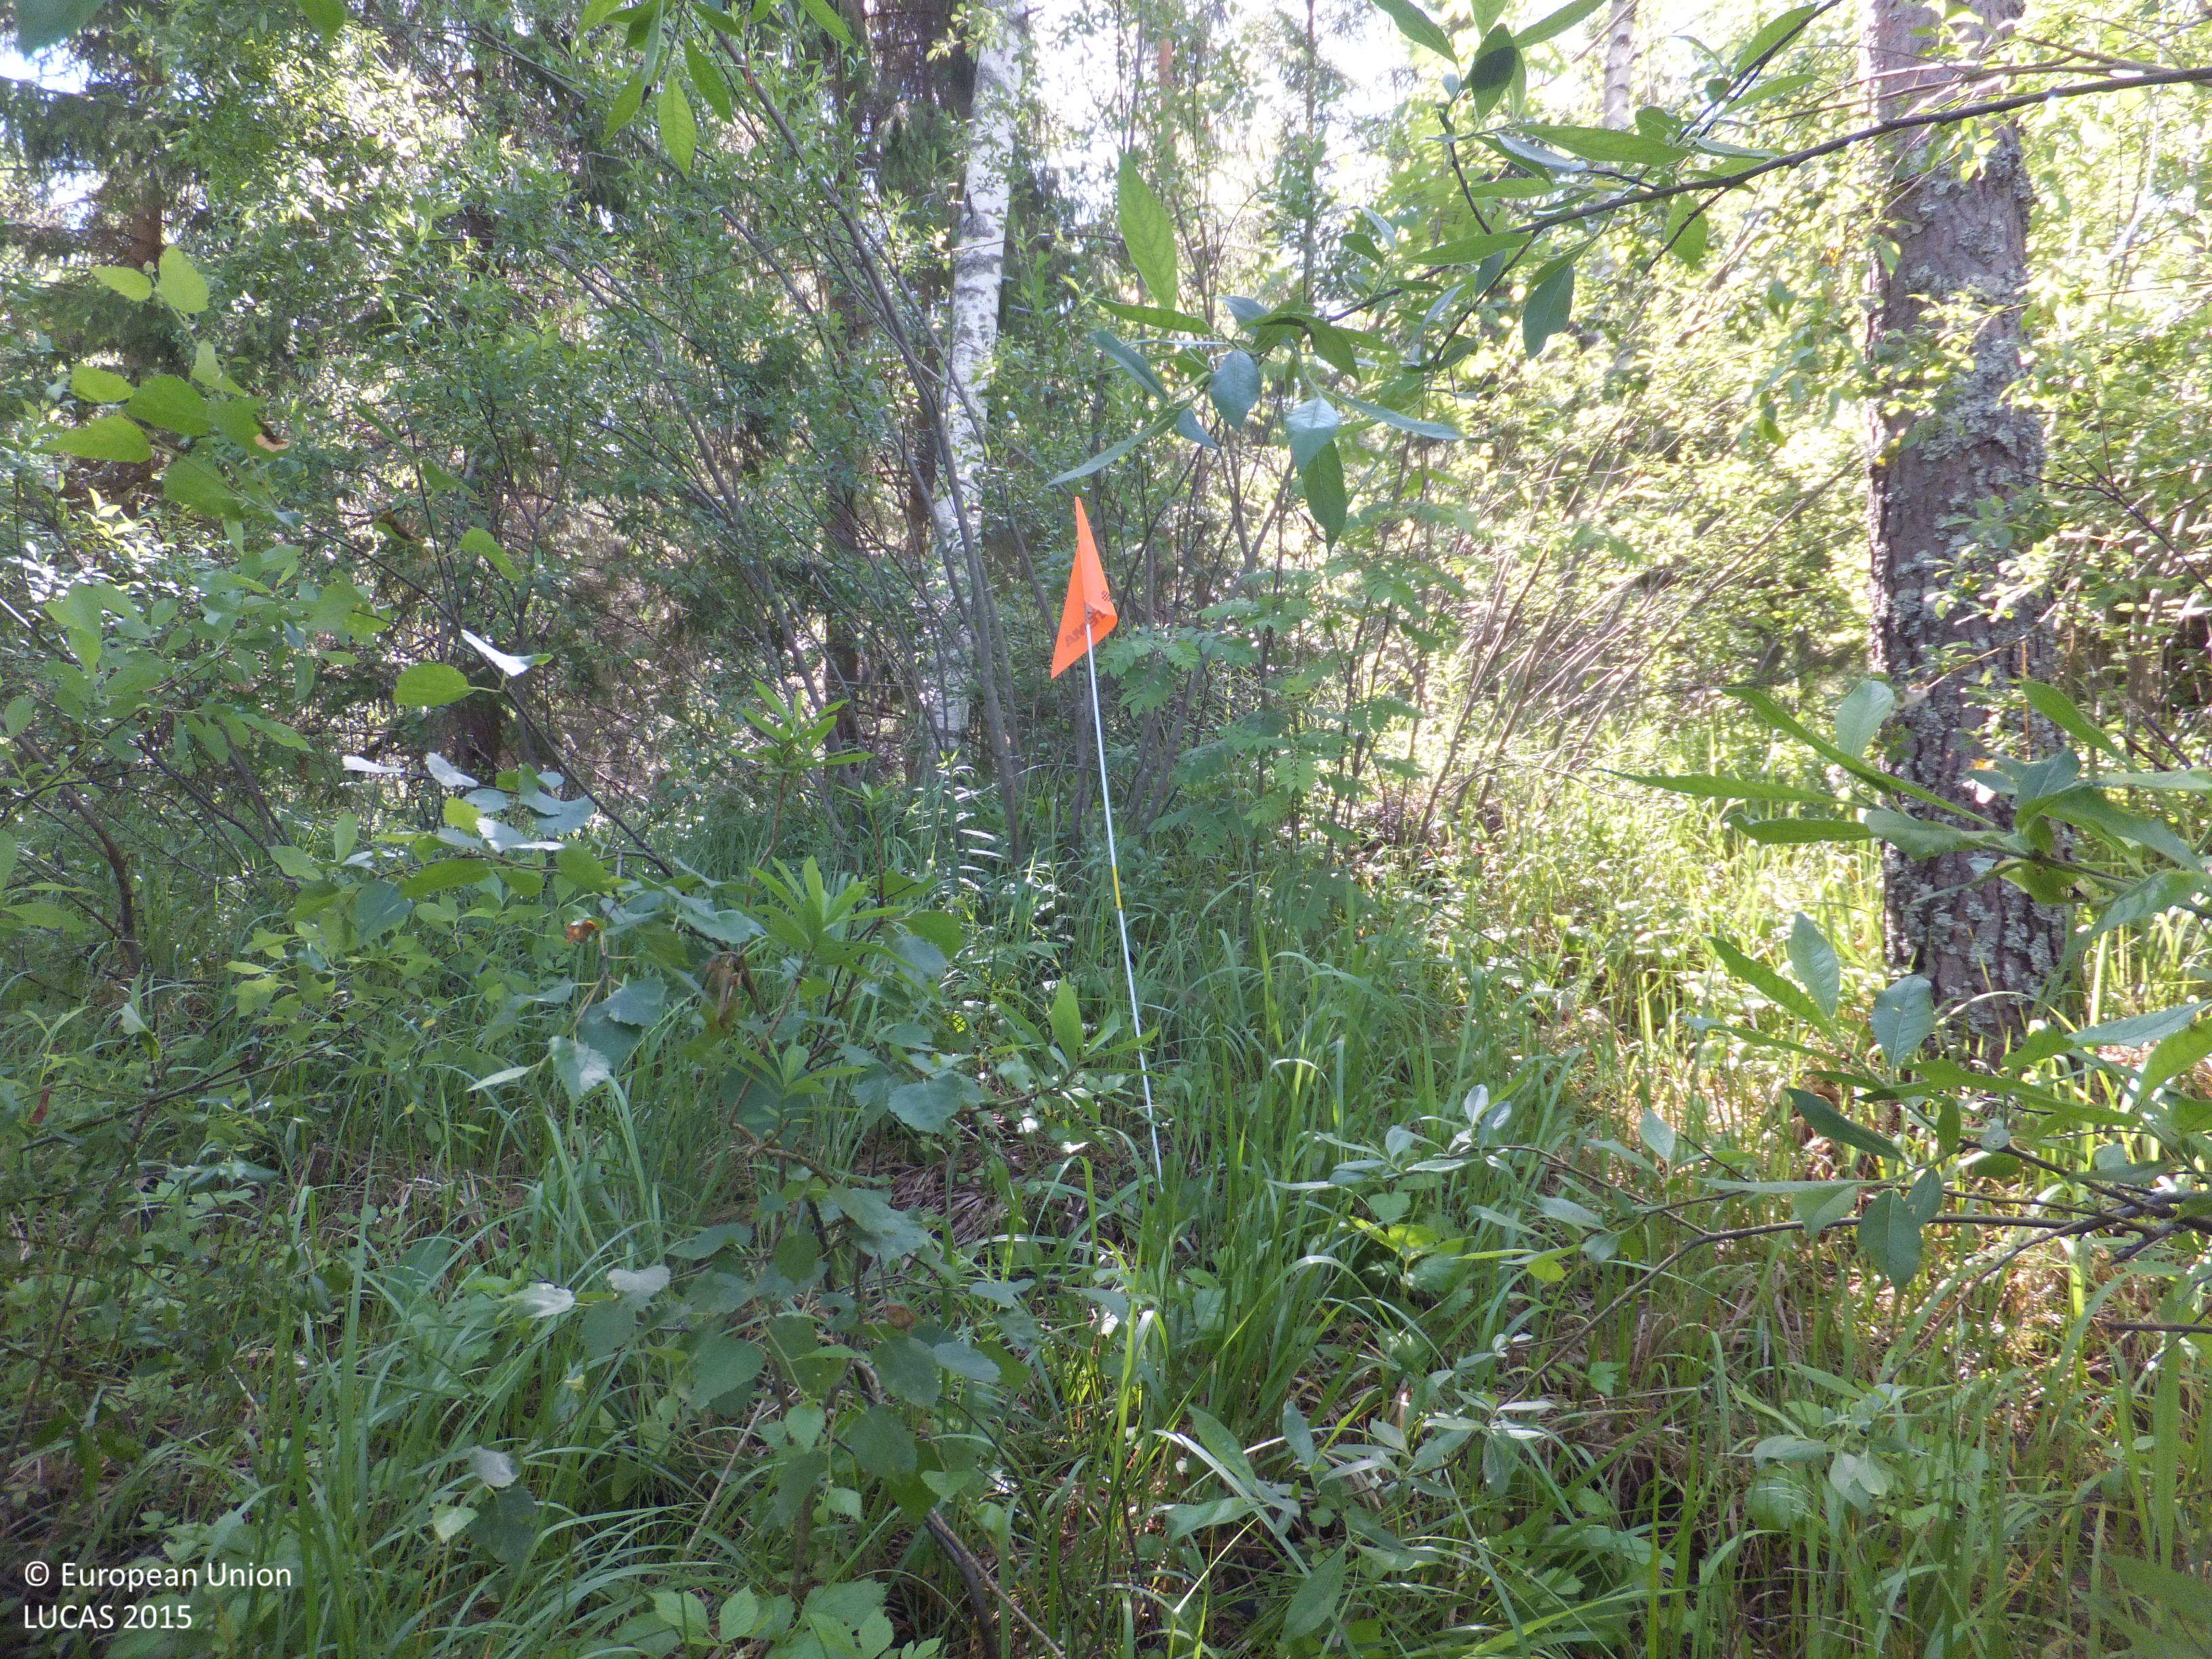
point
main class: Woodland
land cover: Other mixed woodland
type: boreal forest
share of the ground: > 75 %
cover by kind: coniferous forest trees 40 %, broadleaved forest trees 35 %, herbaceous plants 20 %, shrubs 5 %
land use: Forestry
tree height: > 5 m
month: July
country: FI
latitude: 63.1320
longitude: 23.9768
